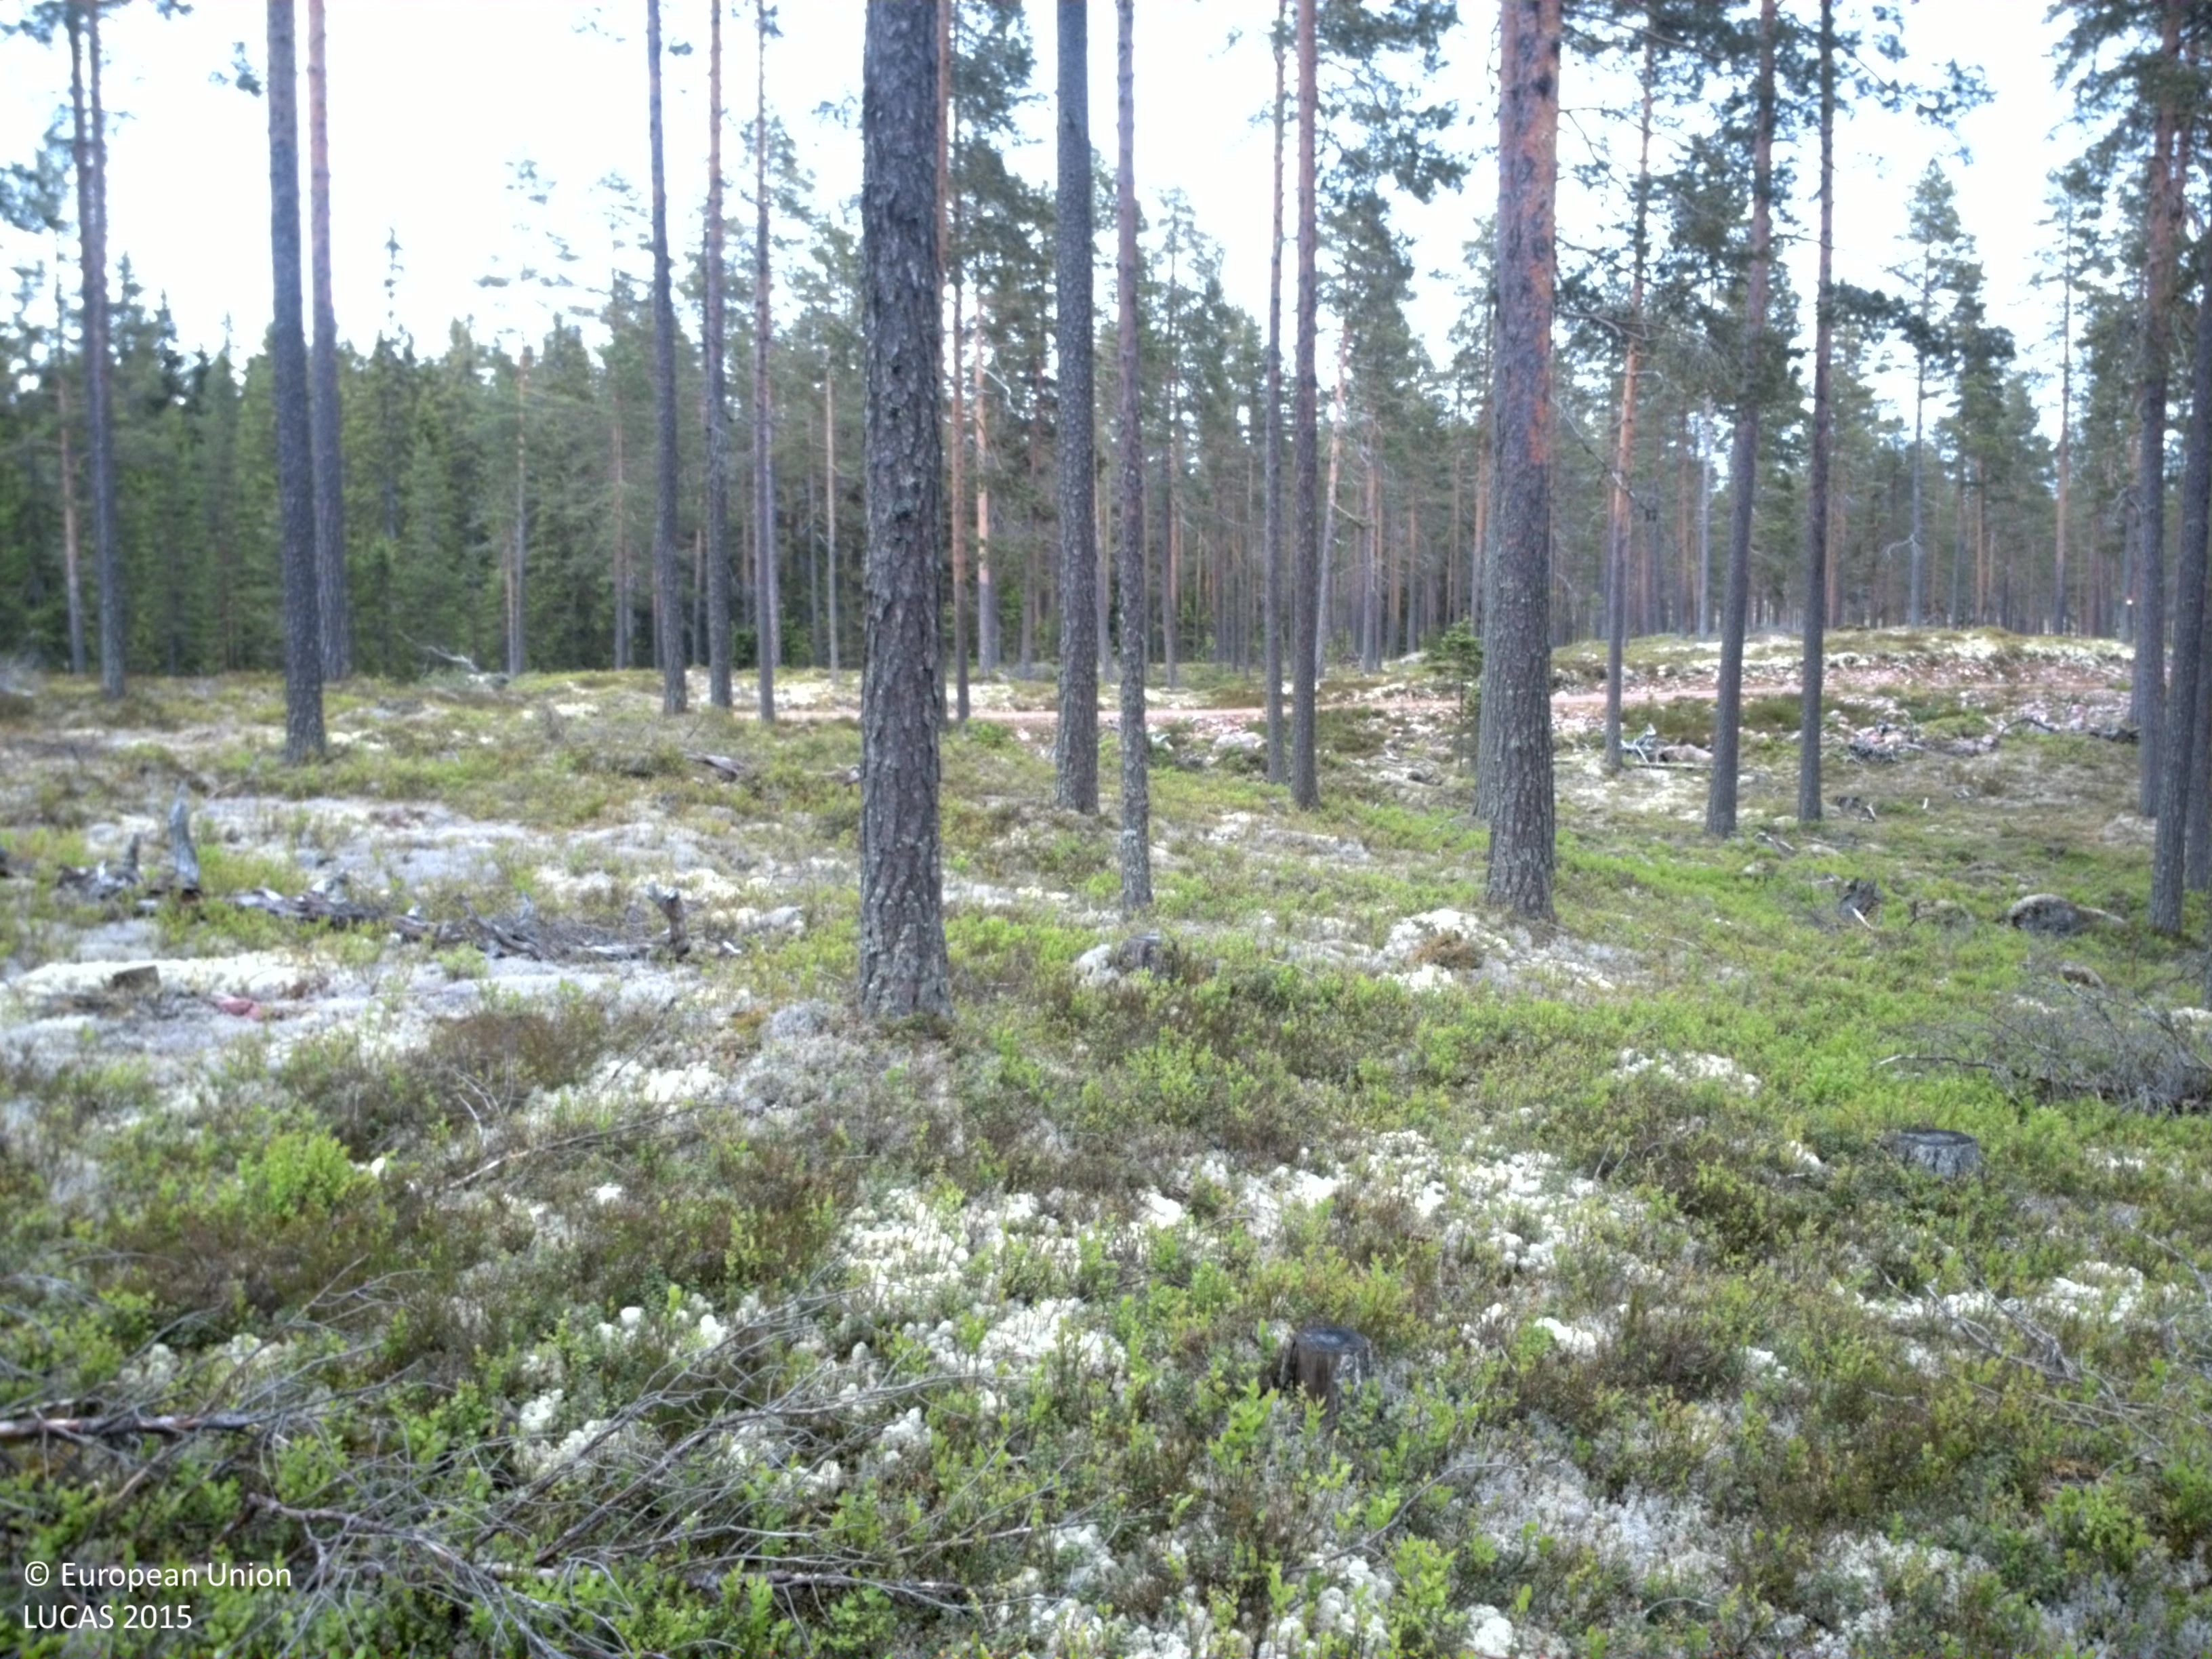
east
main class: Woodland
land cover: Pine dominated coniferous woodland
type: boreal forest
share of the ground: 50 - 75 %
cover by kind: coniferous forest trees 65 %, herbaceous plants 20 %, lichens and mosses 15 %
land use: Forestry
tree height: > 5 m
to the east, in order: Pine dominated coniferous woodland; Rocks and stones; Paved roads, cycling and walking lanes; Pine dominated coniferous woodland; Spruce dominated coniferous woodland; Pine dominated coniferous woodland
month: June
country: SE
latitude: 61.2878
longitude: 13.6262
